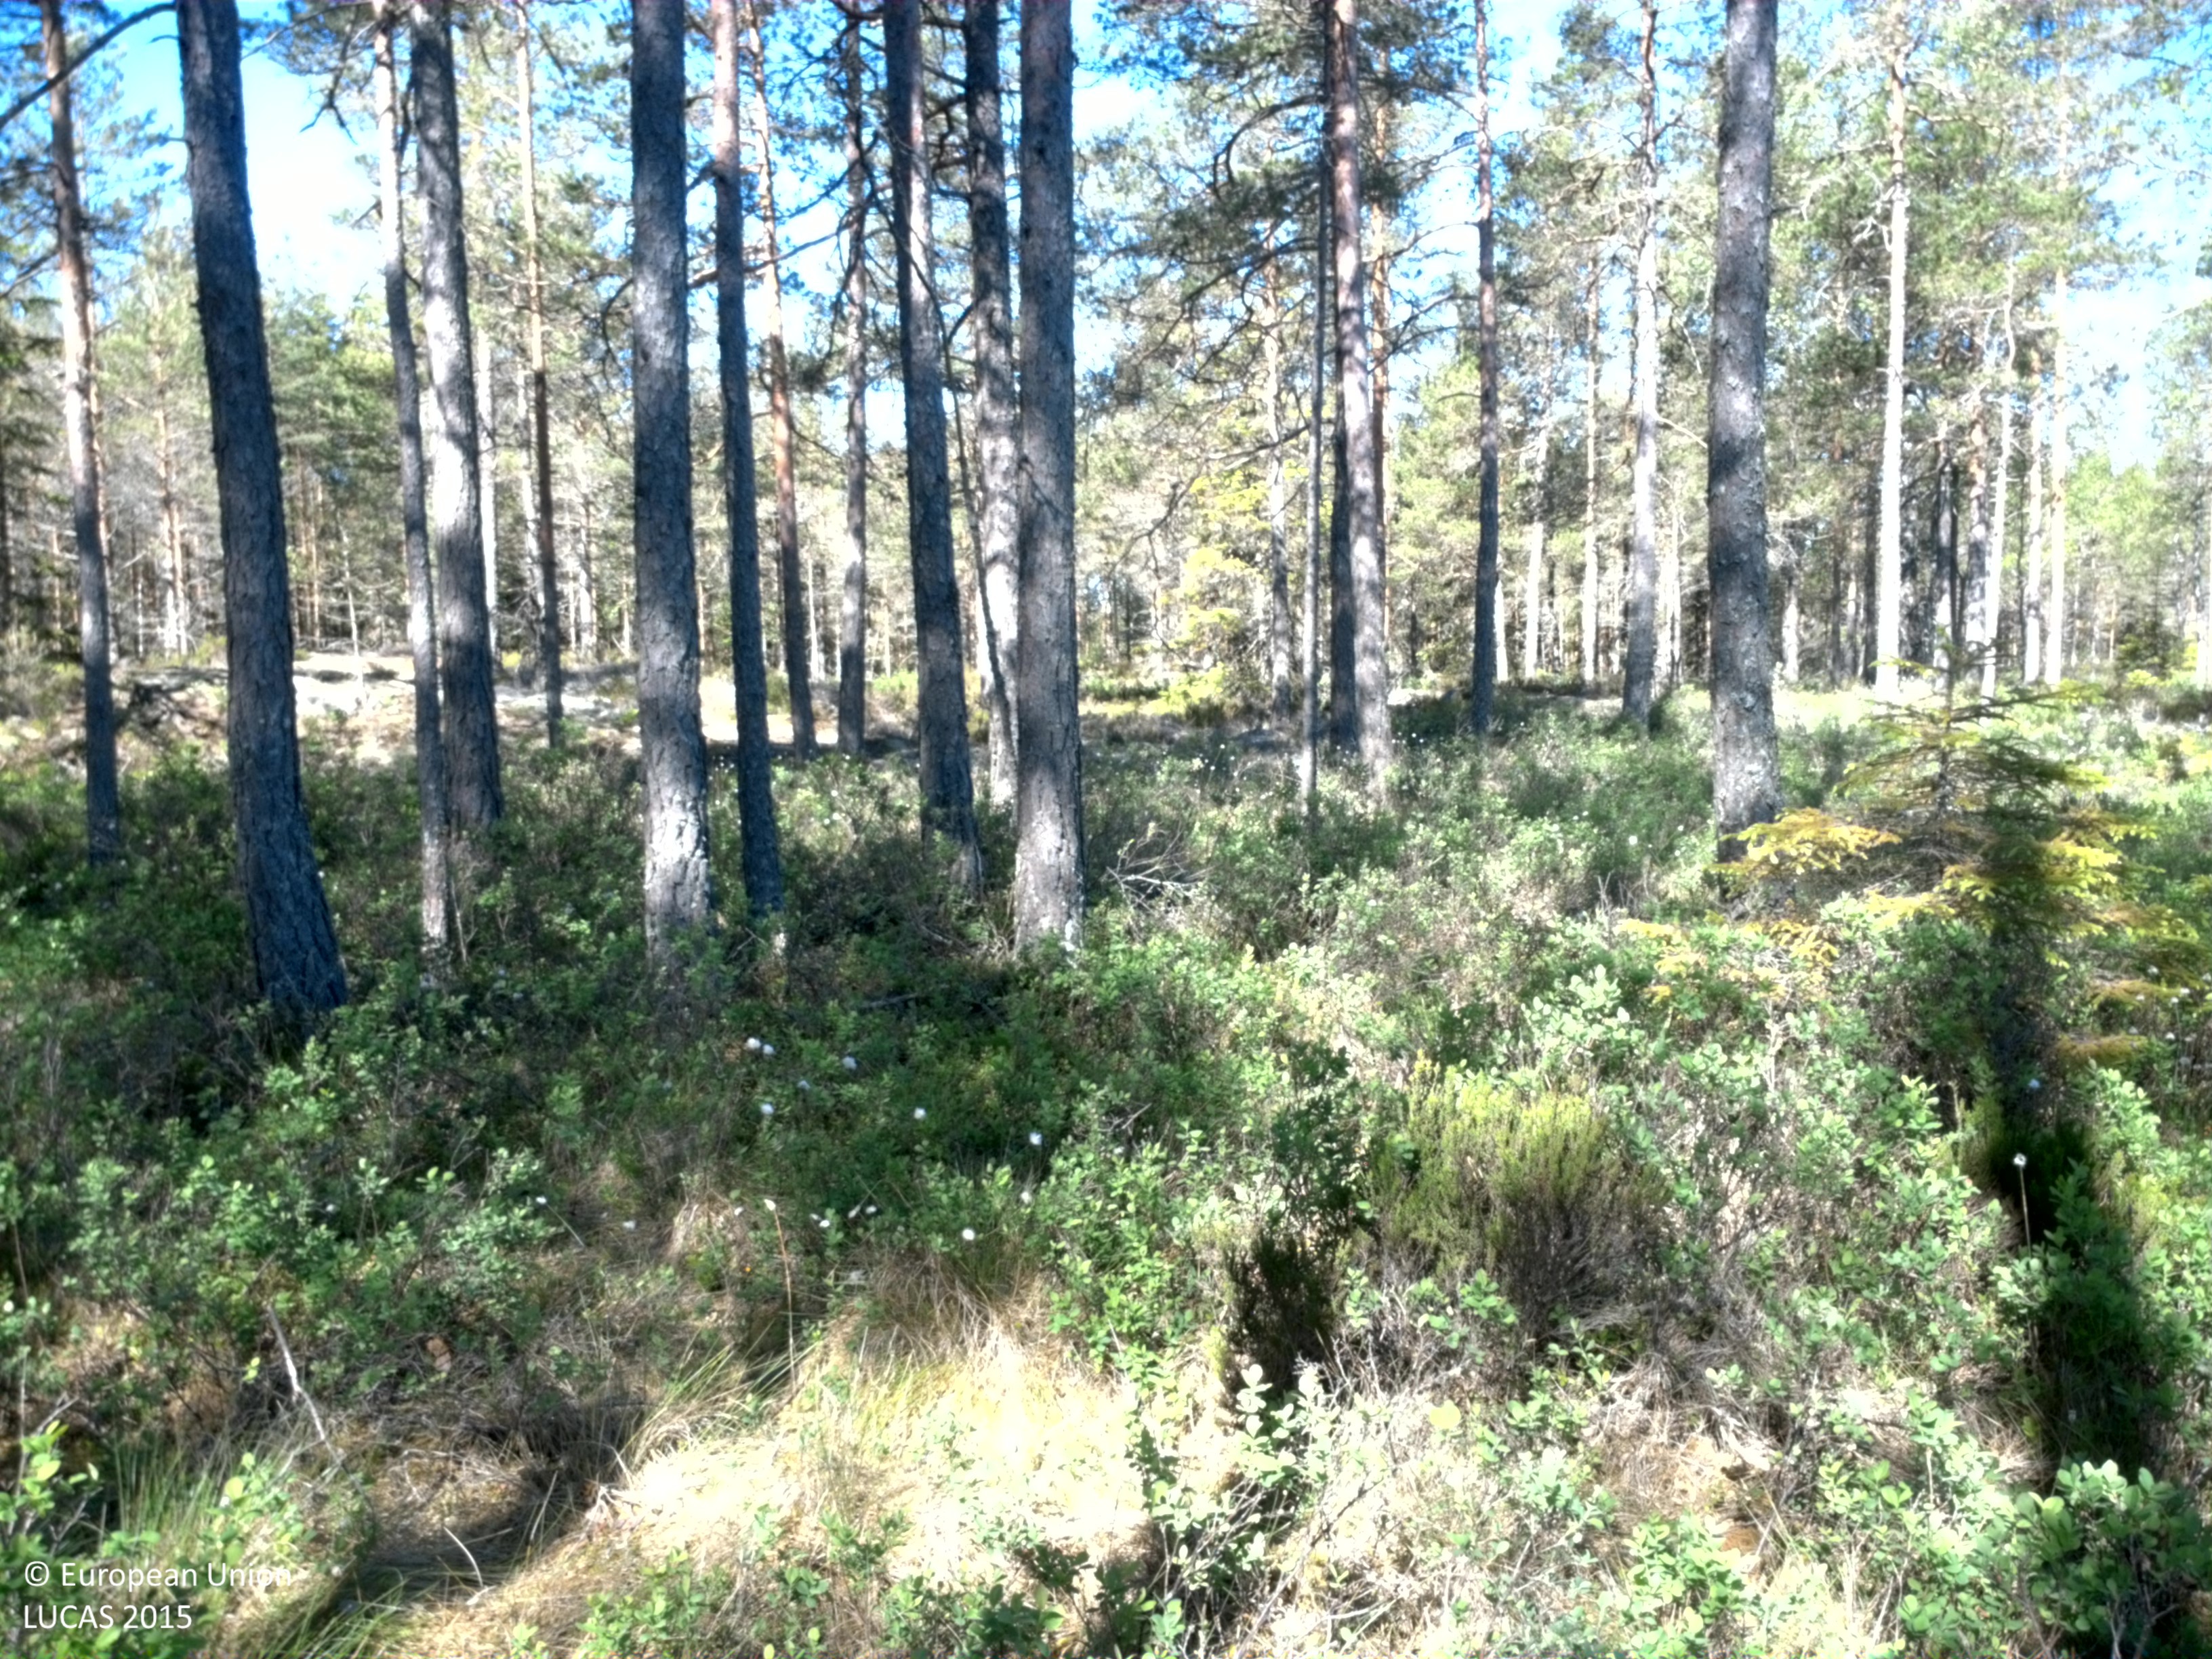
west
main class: Woodland
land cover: Pine dominated coniferous woodland
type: boreal forest
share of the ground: 50 - 75 %
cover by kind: coniferous forest trees 50 %, shrubs 25 %, herbaceous plants 10 %, lichens and mosses 10 %, broadleaved forest trees 5 %
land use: Forestry
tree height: > 5 m
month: June
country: SE
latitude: 59.4994
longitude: 12.0613
